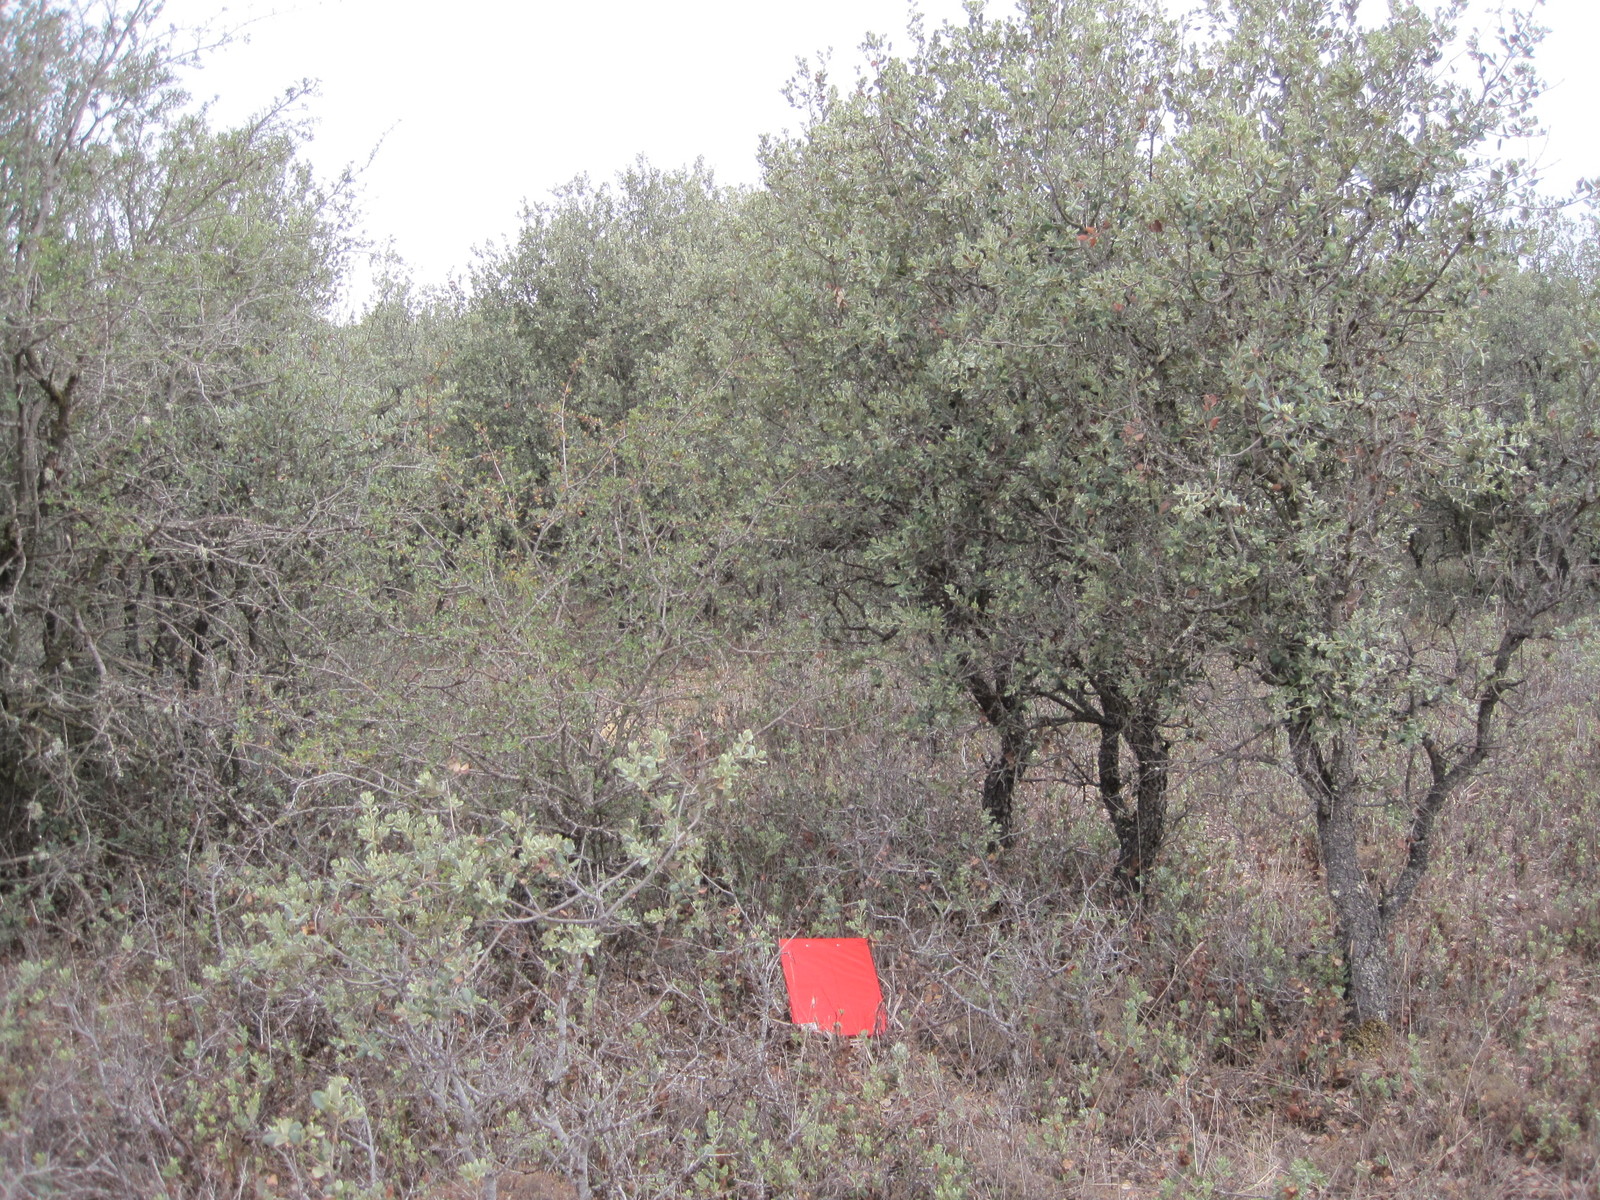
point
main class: Woodland
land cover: Broadleaved woodland
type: broadleaved evergreen forest
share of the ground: 50 - 75 %
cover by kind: broadleaved forest trees 60 %, herbaceous plants 40 %
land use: Forestry
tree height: > 5 m
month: July
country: ES
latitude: 41.7729
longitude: -5.4465
